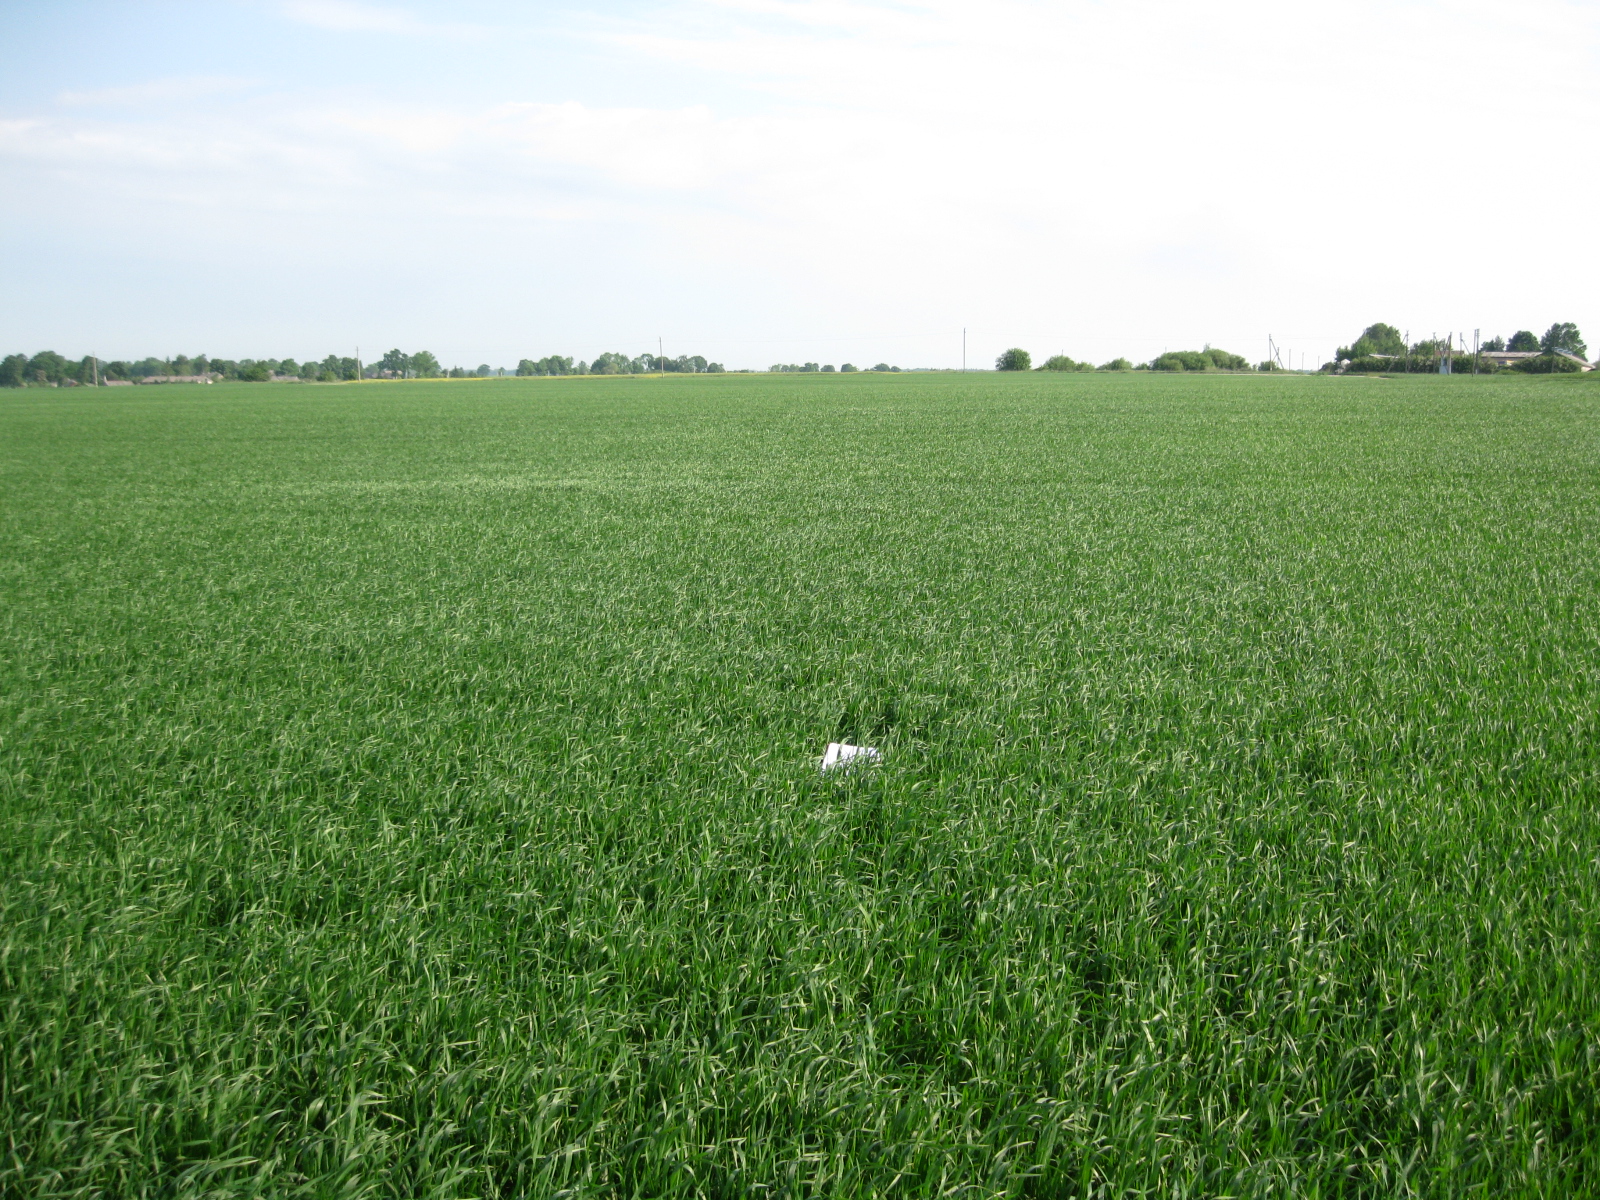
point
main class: Cropland
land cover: Common wheat
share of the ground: > 75 %
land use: Agriculture (excluding fallow land and kitchen gardens)
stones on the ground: < 10 %
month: June
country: LT
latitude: 55.7966
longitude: 23.6878
